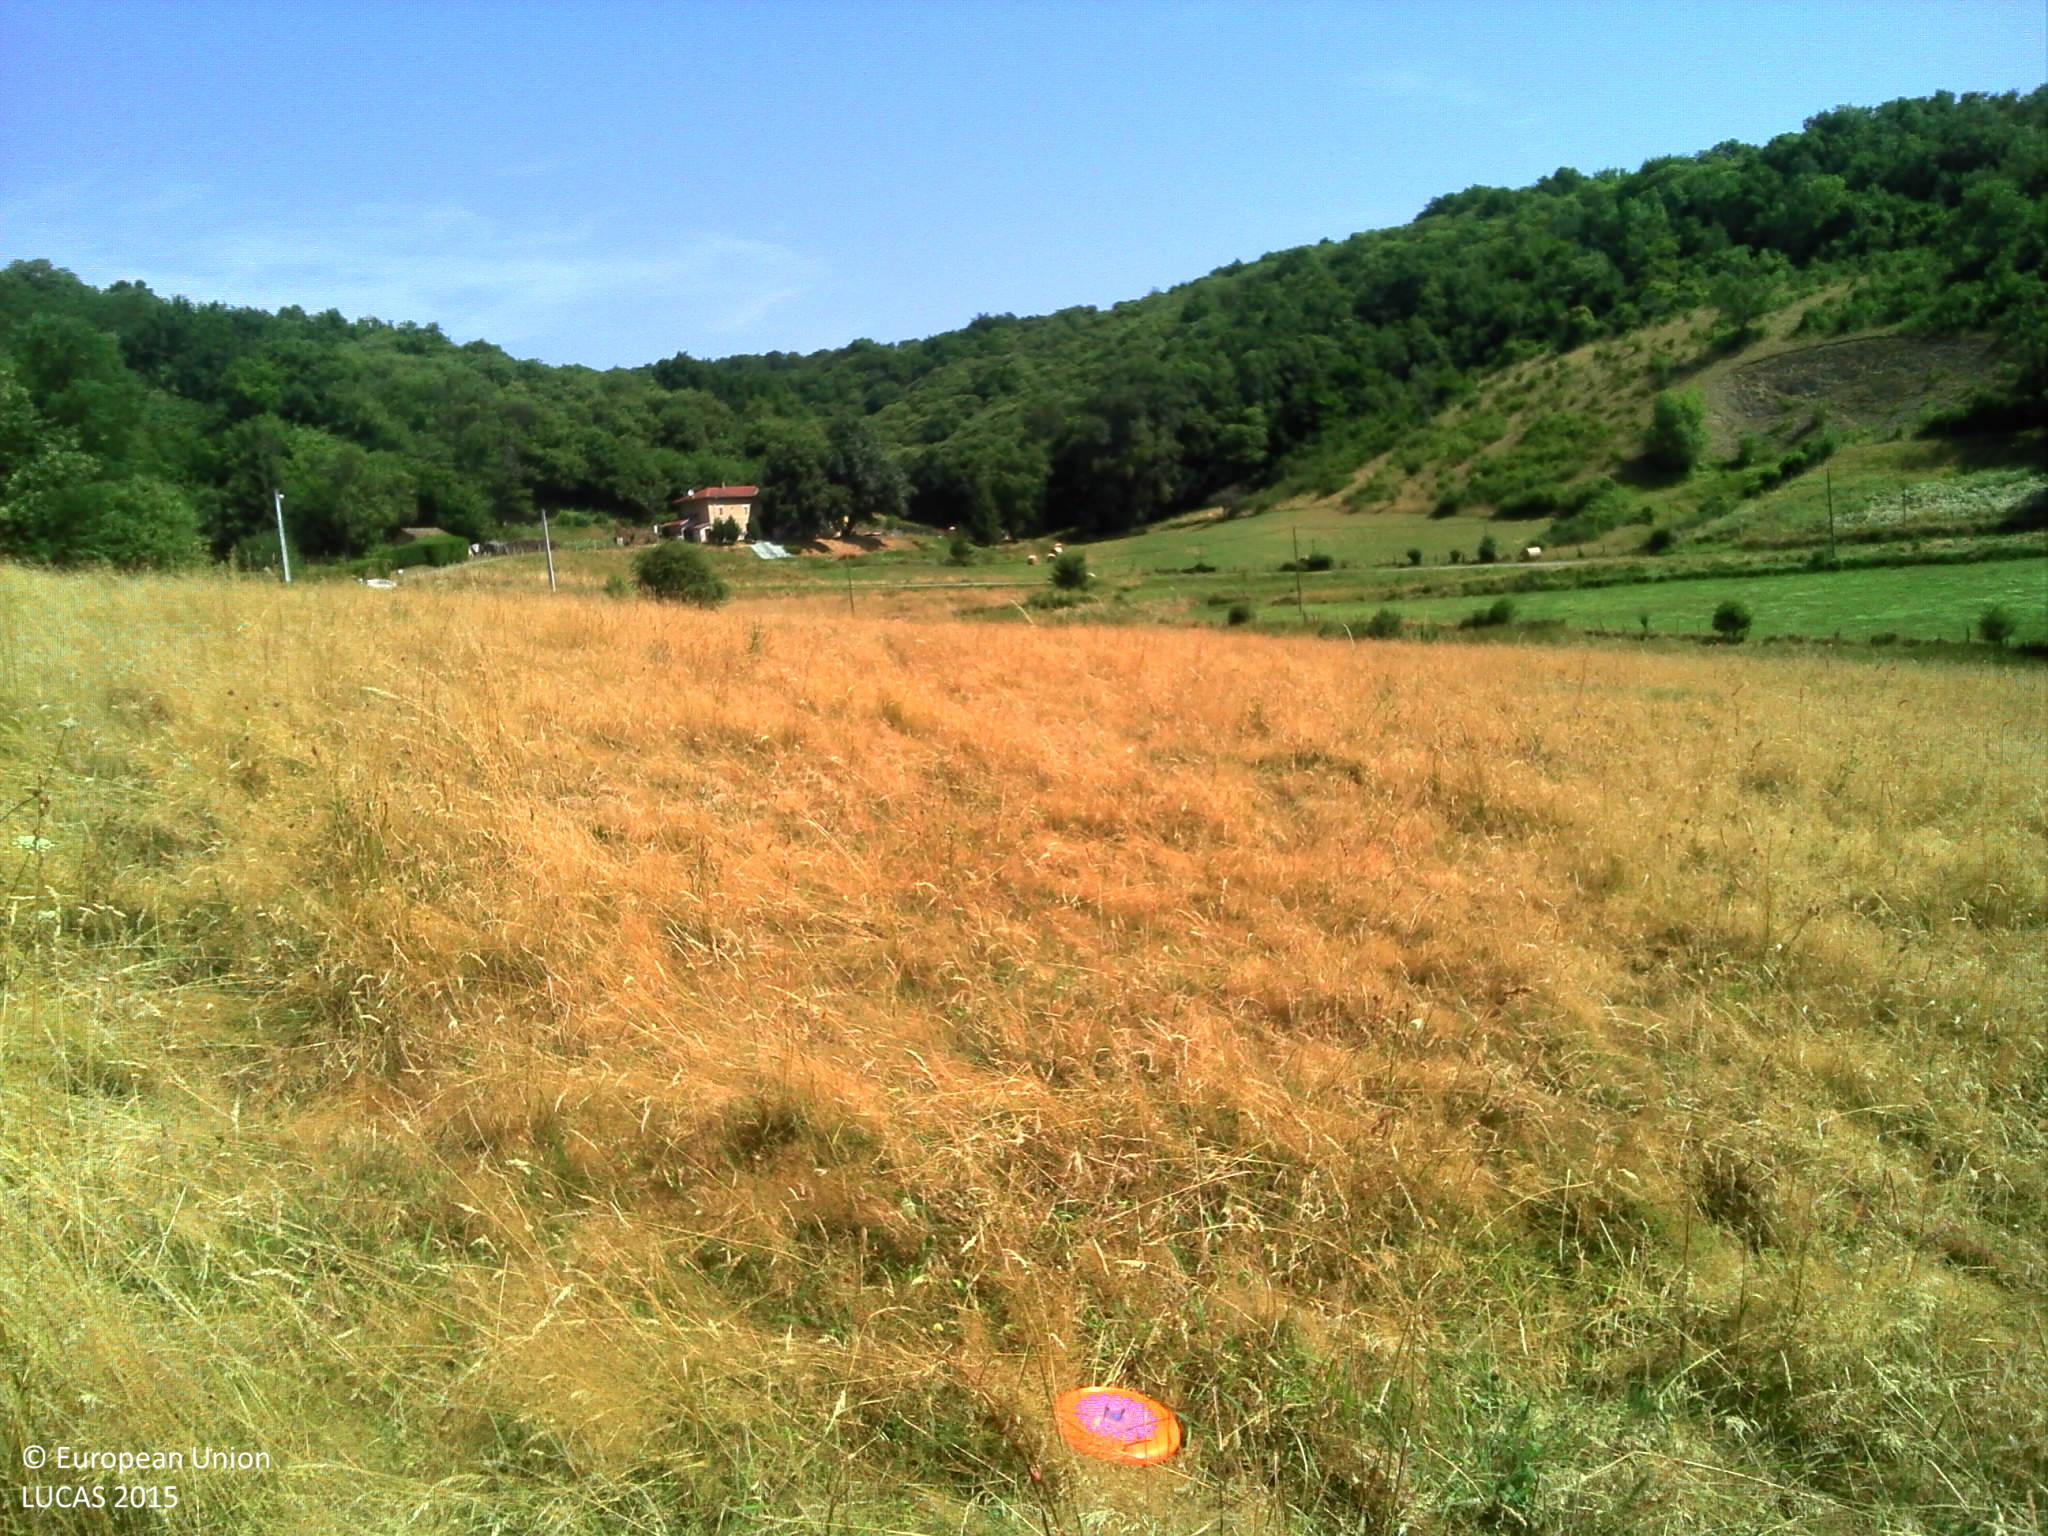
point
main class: Grassland
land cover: Grassland without tree/shrub cover
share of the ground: > 75 %
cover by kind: herbaceous plants 100 %
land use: Agriculture (excluding fallow land and kitchen gardens)
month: July
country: FR
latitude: 45.4307
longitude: 5.1858
